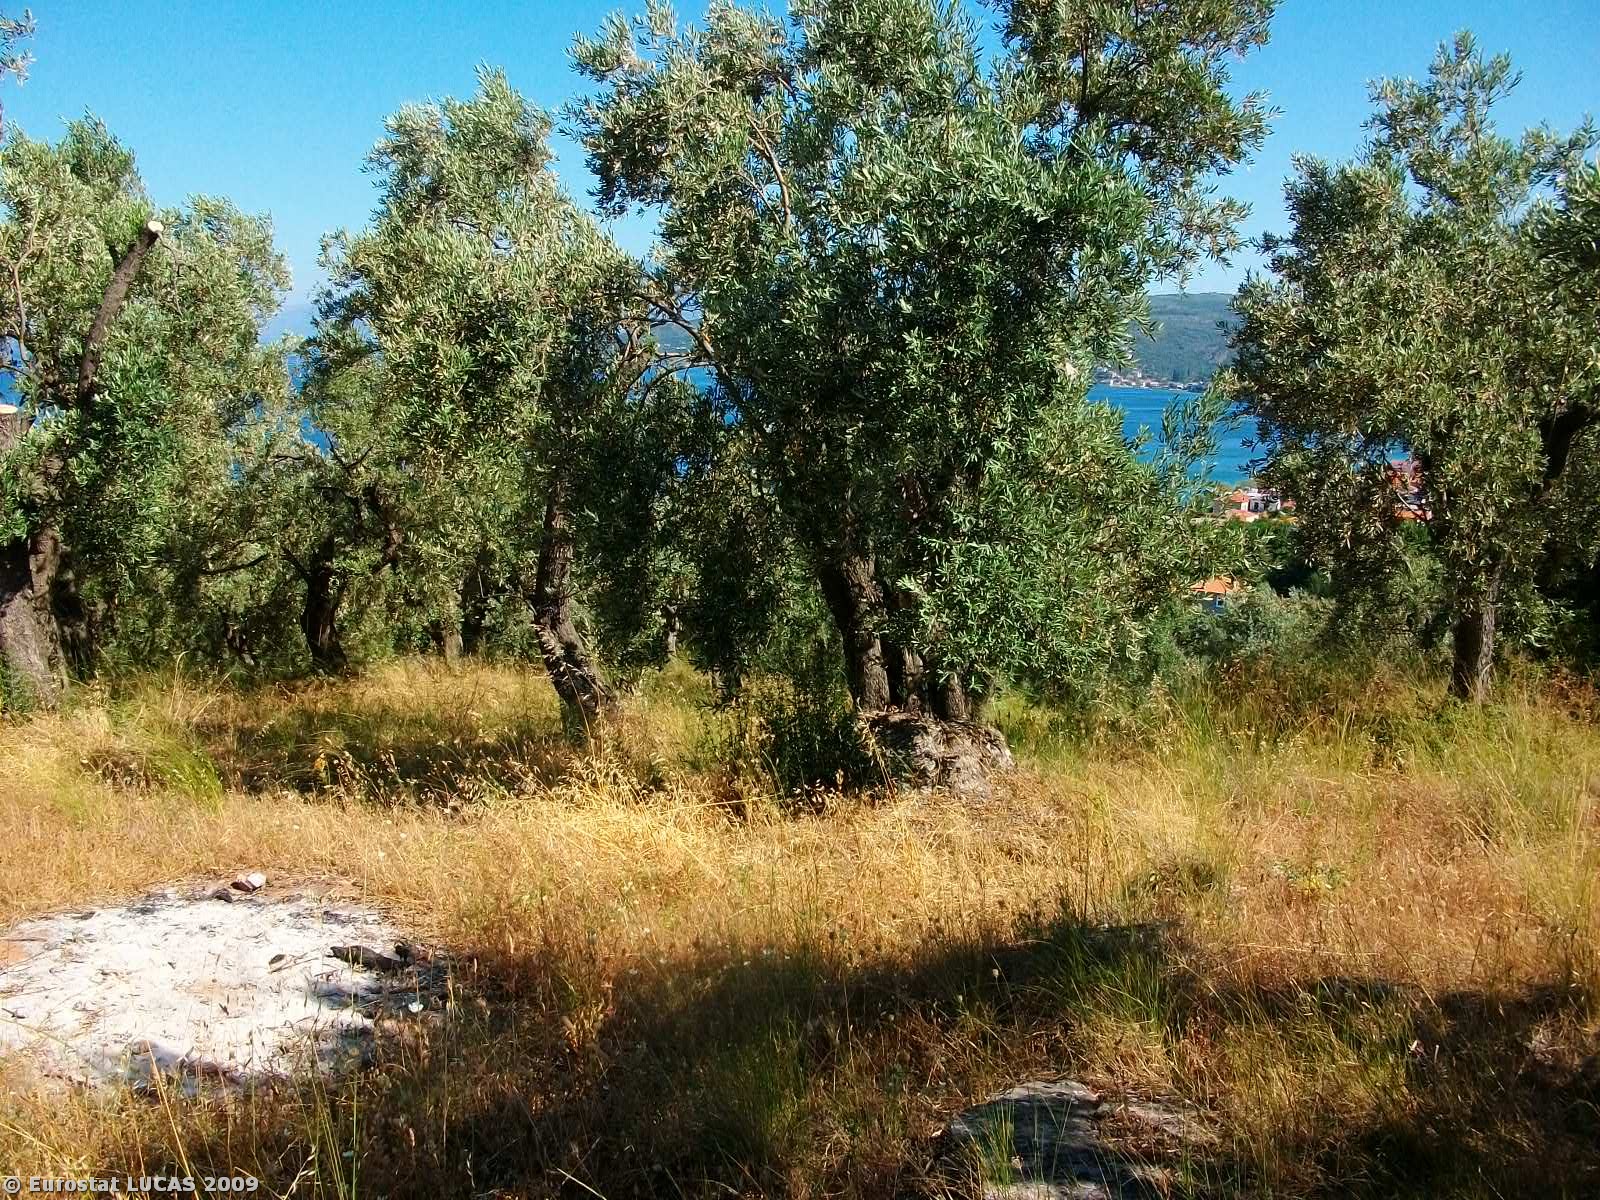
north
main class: Cropland
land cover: Olive groves
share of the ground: 50 - 75 %
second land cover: Grassland with sparse tree/shrub cover
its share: > 75 %
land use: Agriculture (excluding fallow land and kitchen gardens)
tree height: < 5 m
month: June
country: GR
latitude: 39.1669
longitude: 23.2208
